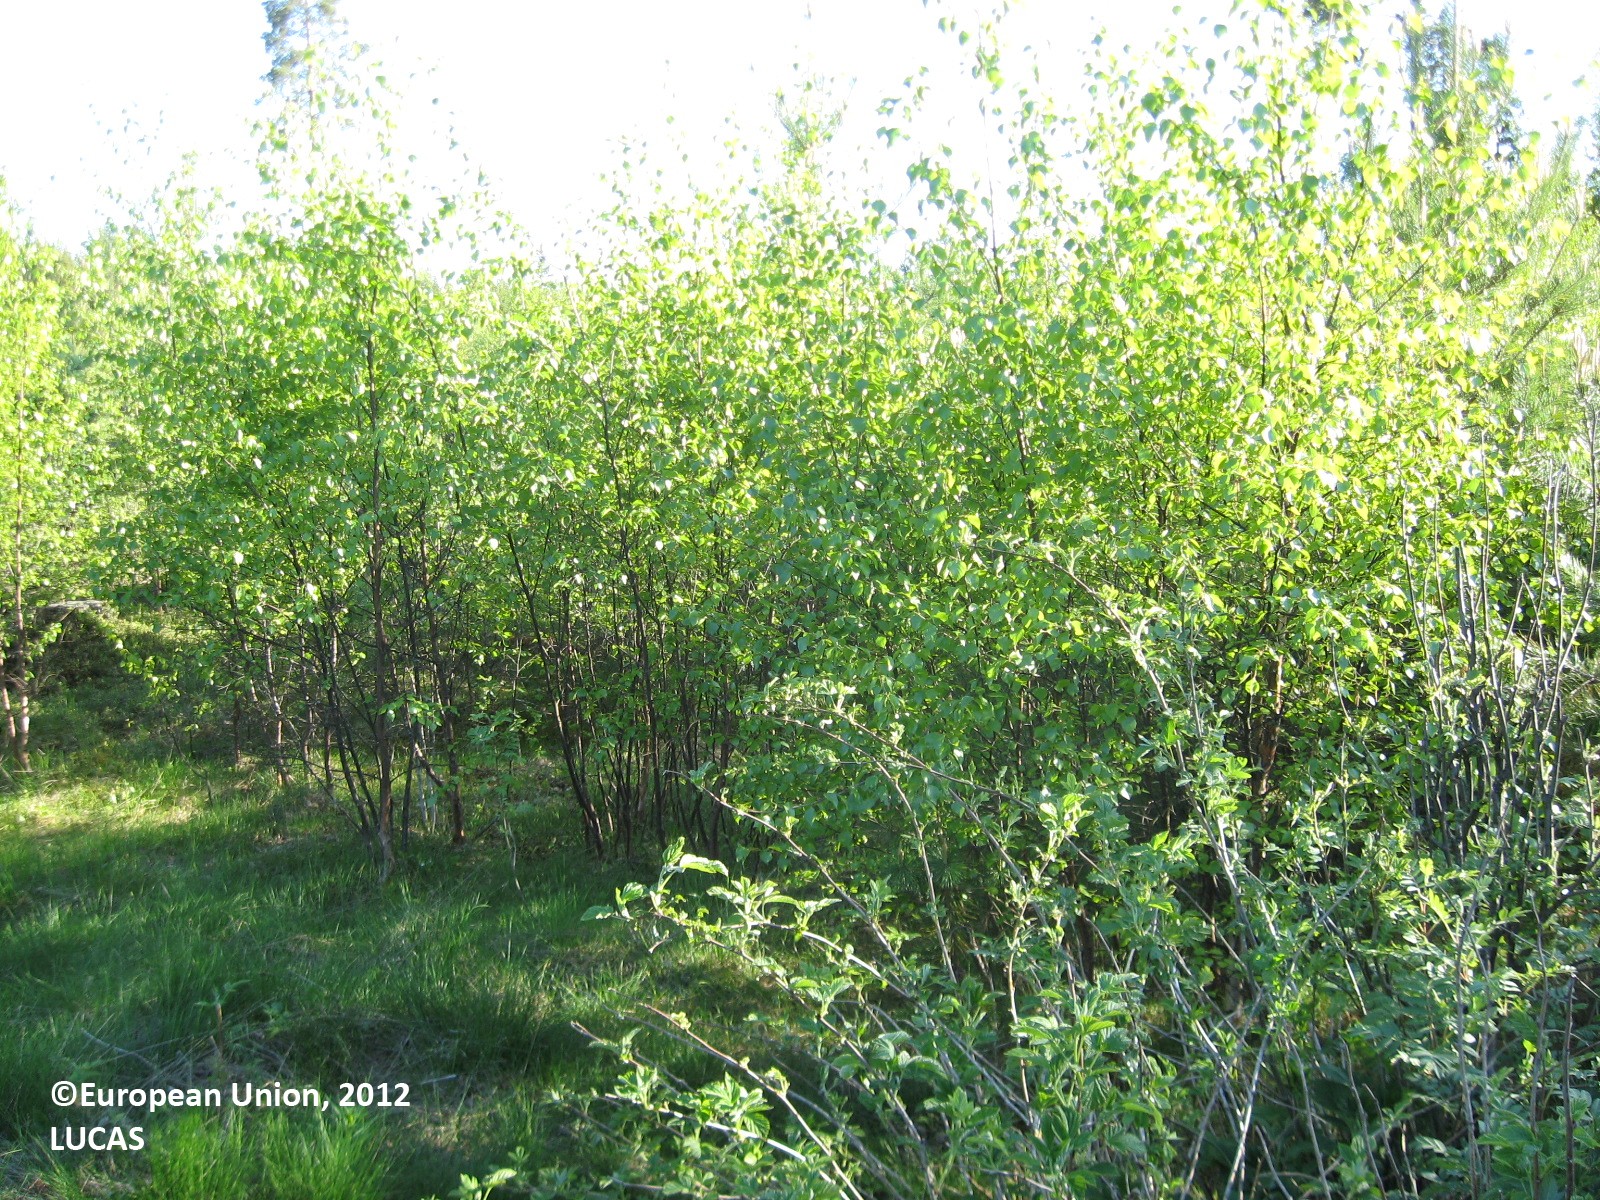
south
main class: Woodland
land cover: Pine dominated mixed woodland
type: boreal forest
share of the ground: 50 - 75 %
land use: Forestry
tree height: < 5 m
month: June
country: FI
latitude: 63.1777
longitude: 21.7007
